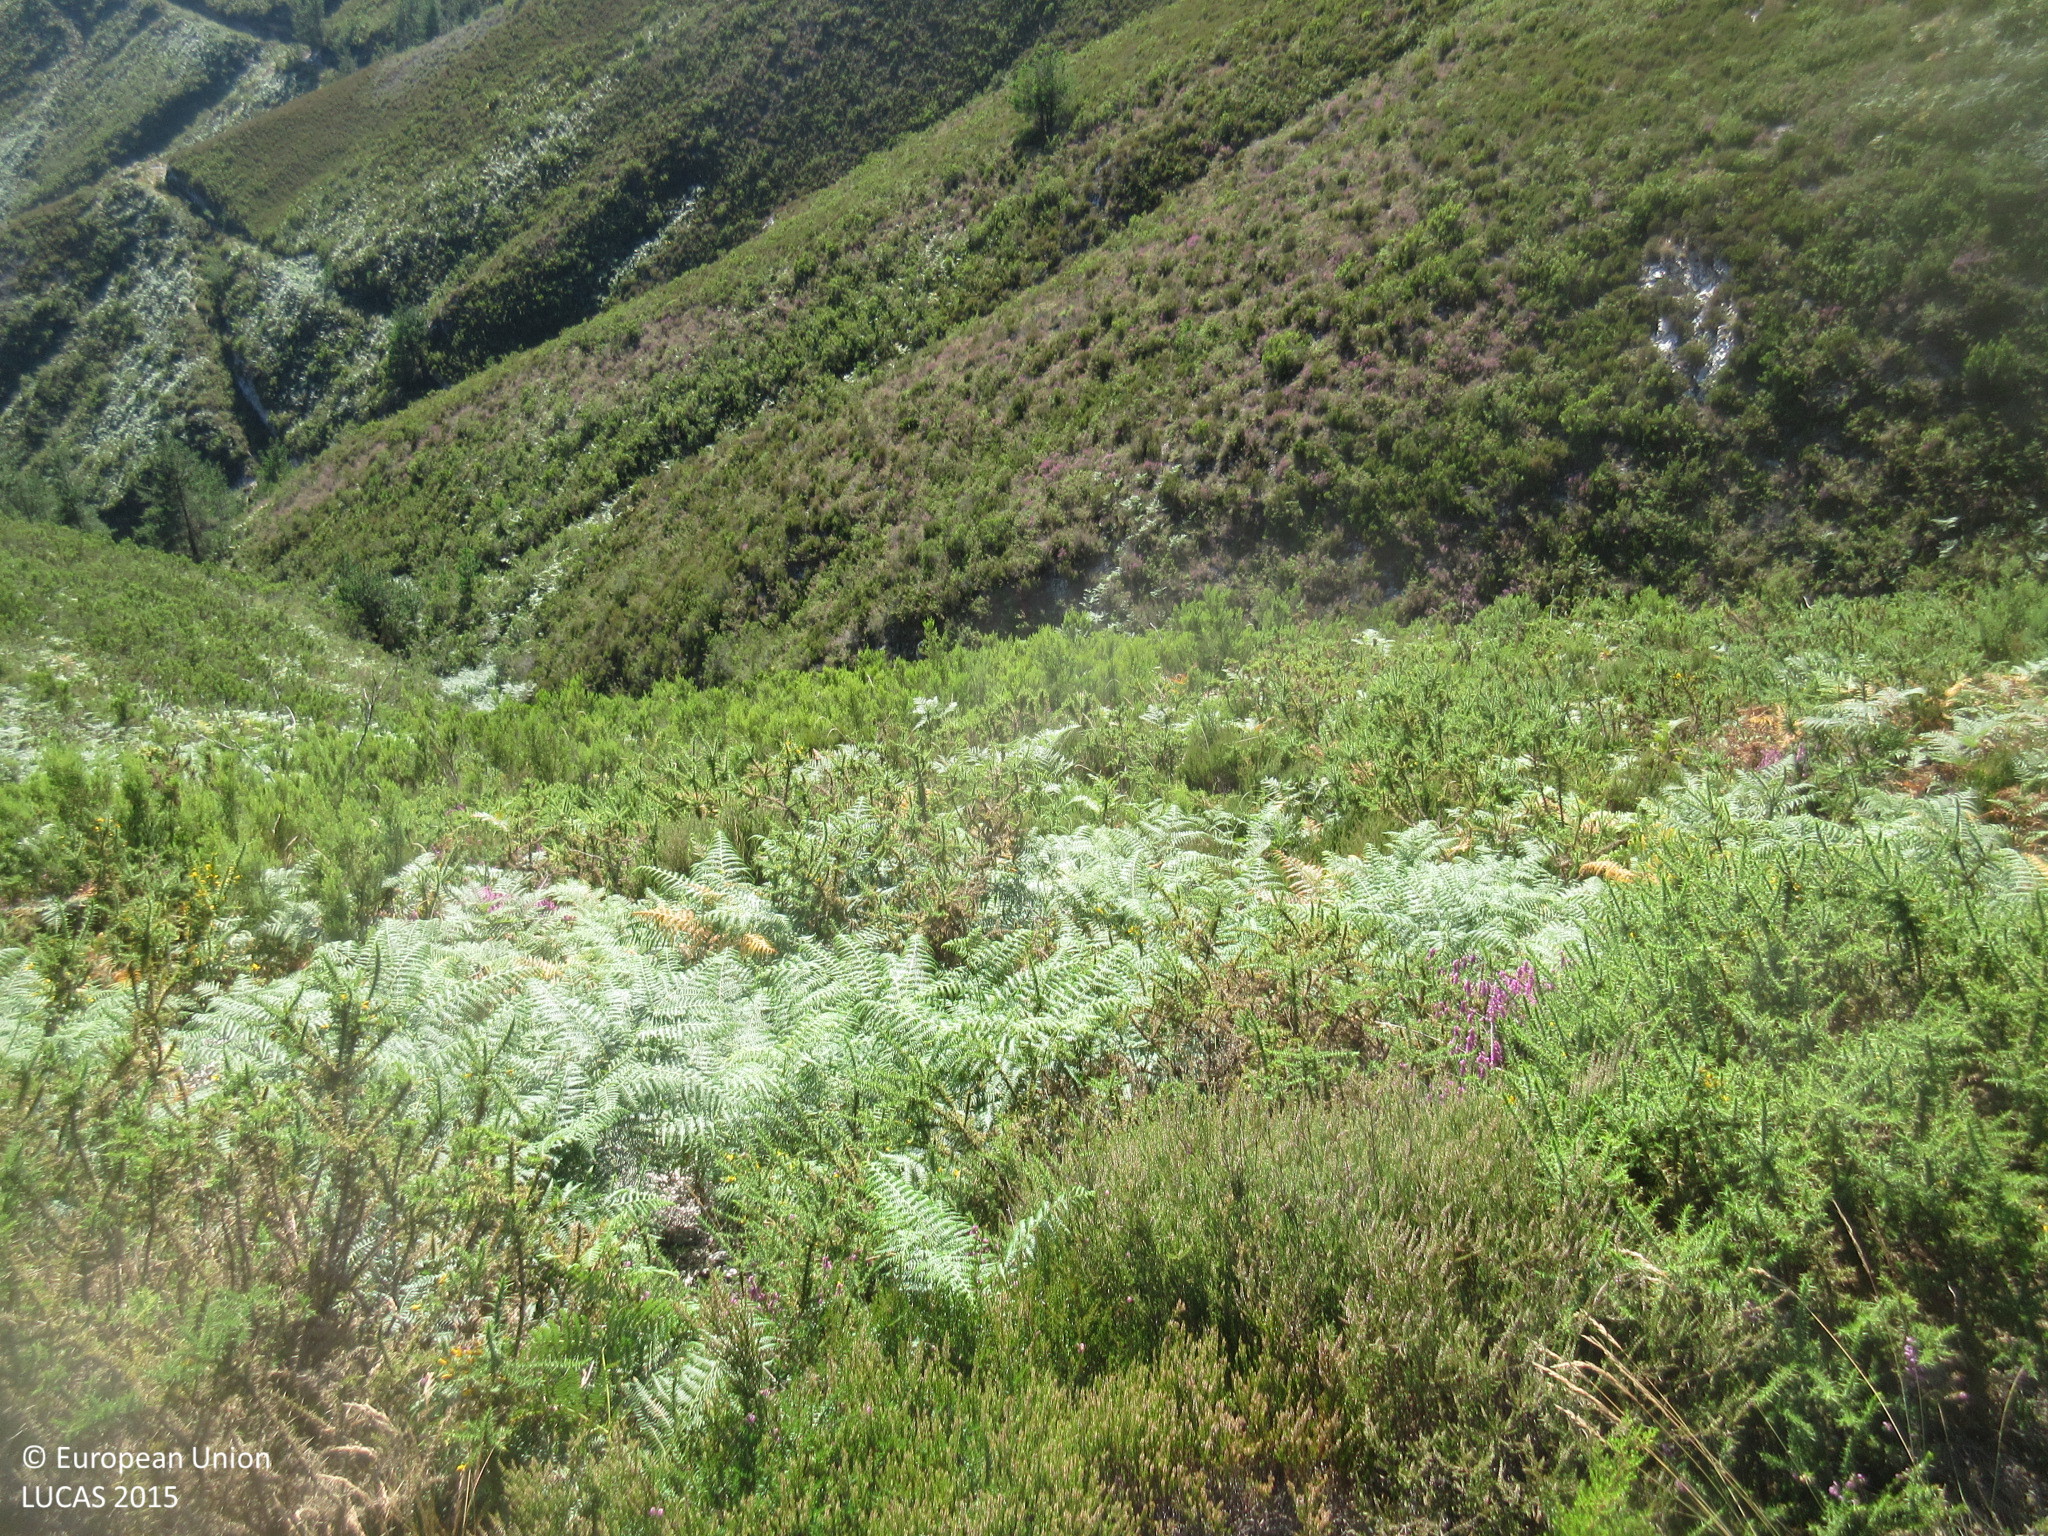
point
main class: Shrubland
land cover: Shrubland without tree cover
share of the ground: > 75 %
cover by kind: shrubs 100 %
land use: Agriculture (excluding fallow land and kitchen gardens)
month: July
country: ES
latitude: 43.3642
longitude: -5.1143
